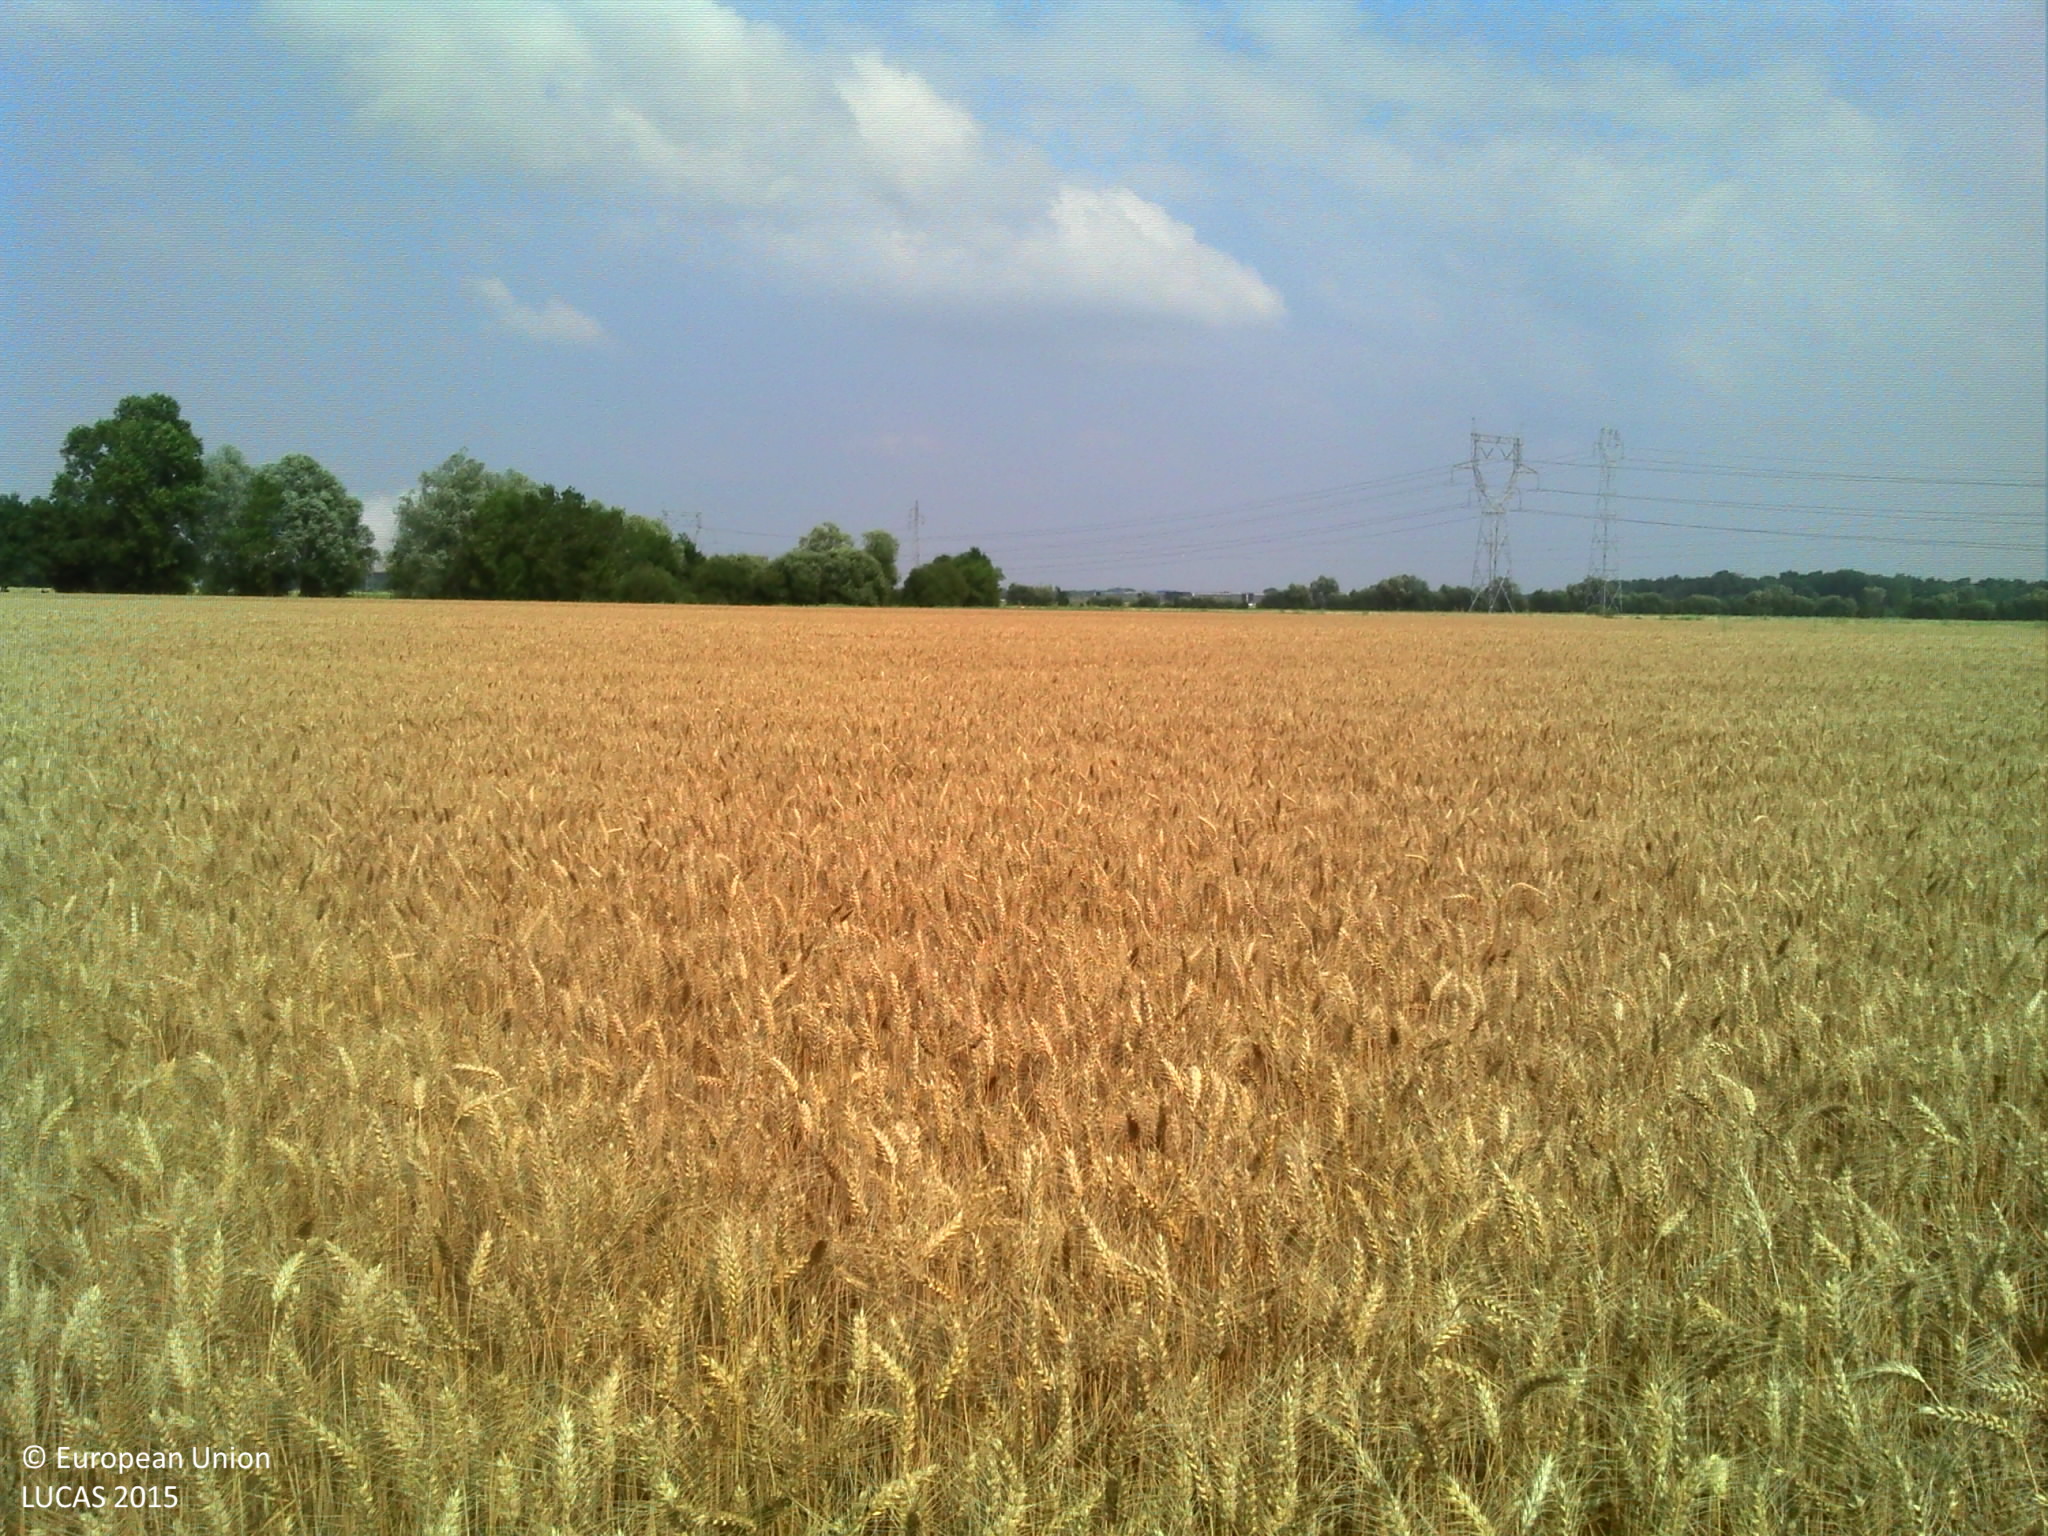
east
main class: Cropland
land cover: Durum wheat
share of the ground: > 75 %
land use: Agriculture (excluding fallow land and kitchen gardens)
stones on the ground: < 10 %
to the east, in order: Durum wheat; Maize; Broadleaved woodland; Inland marshes
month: July
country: FR
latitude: 47.2184
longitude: 0.1388
